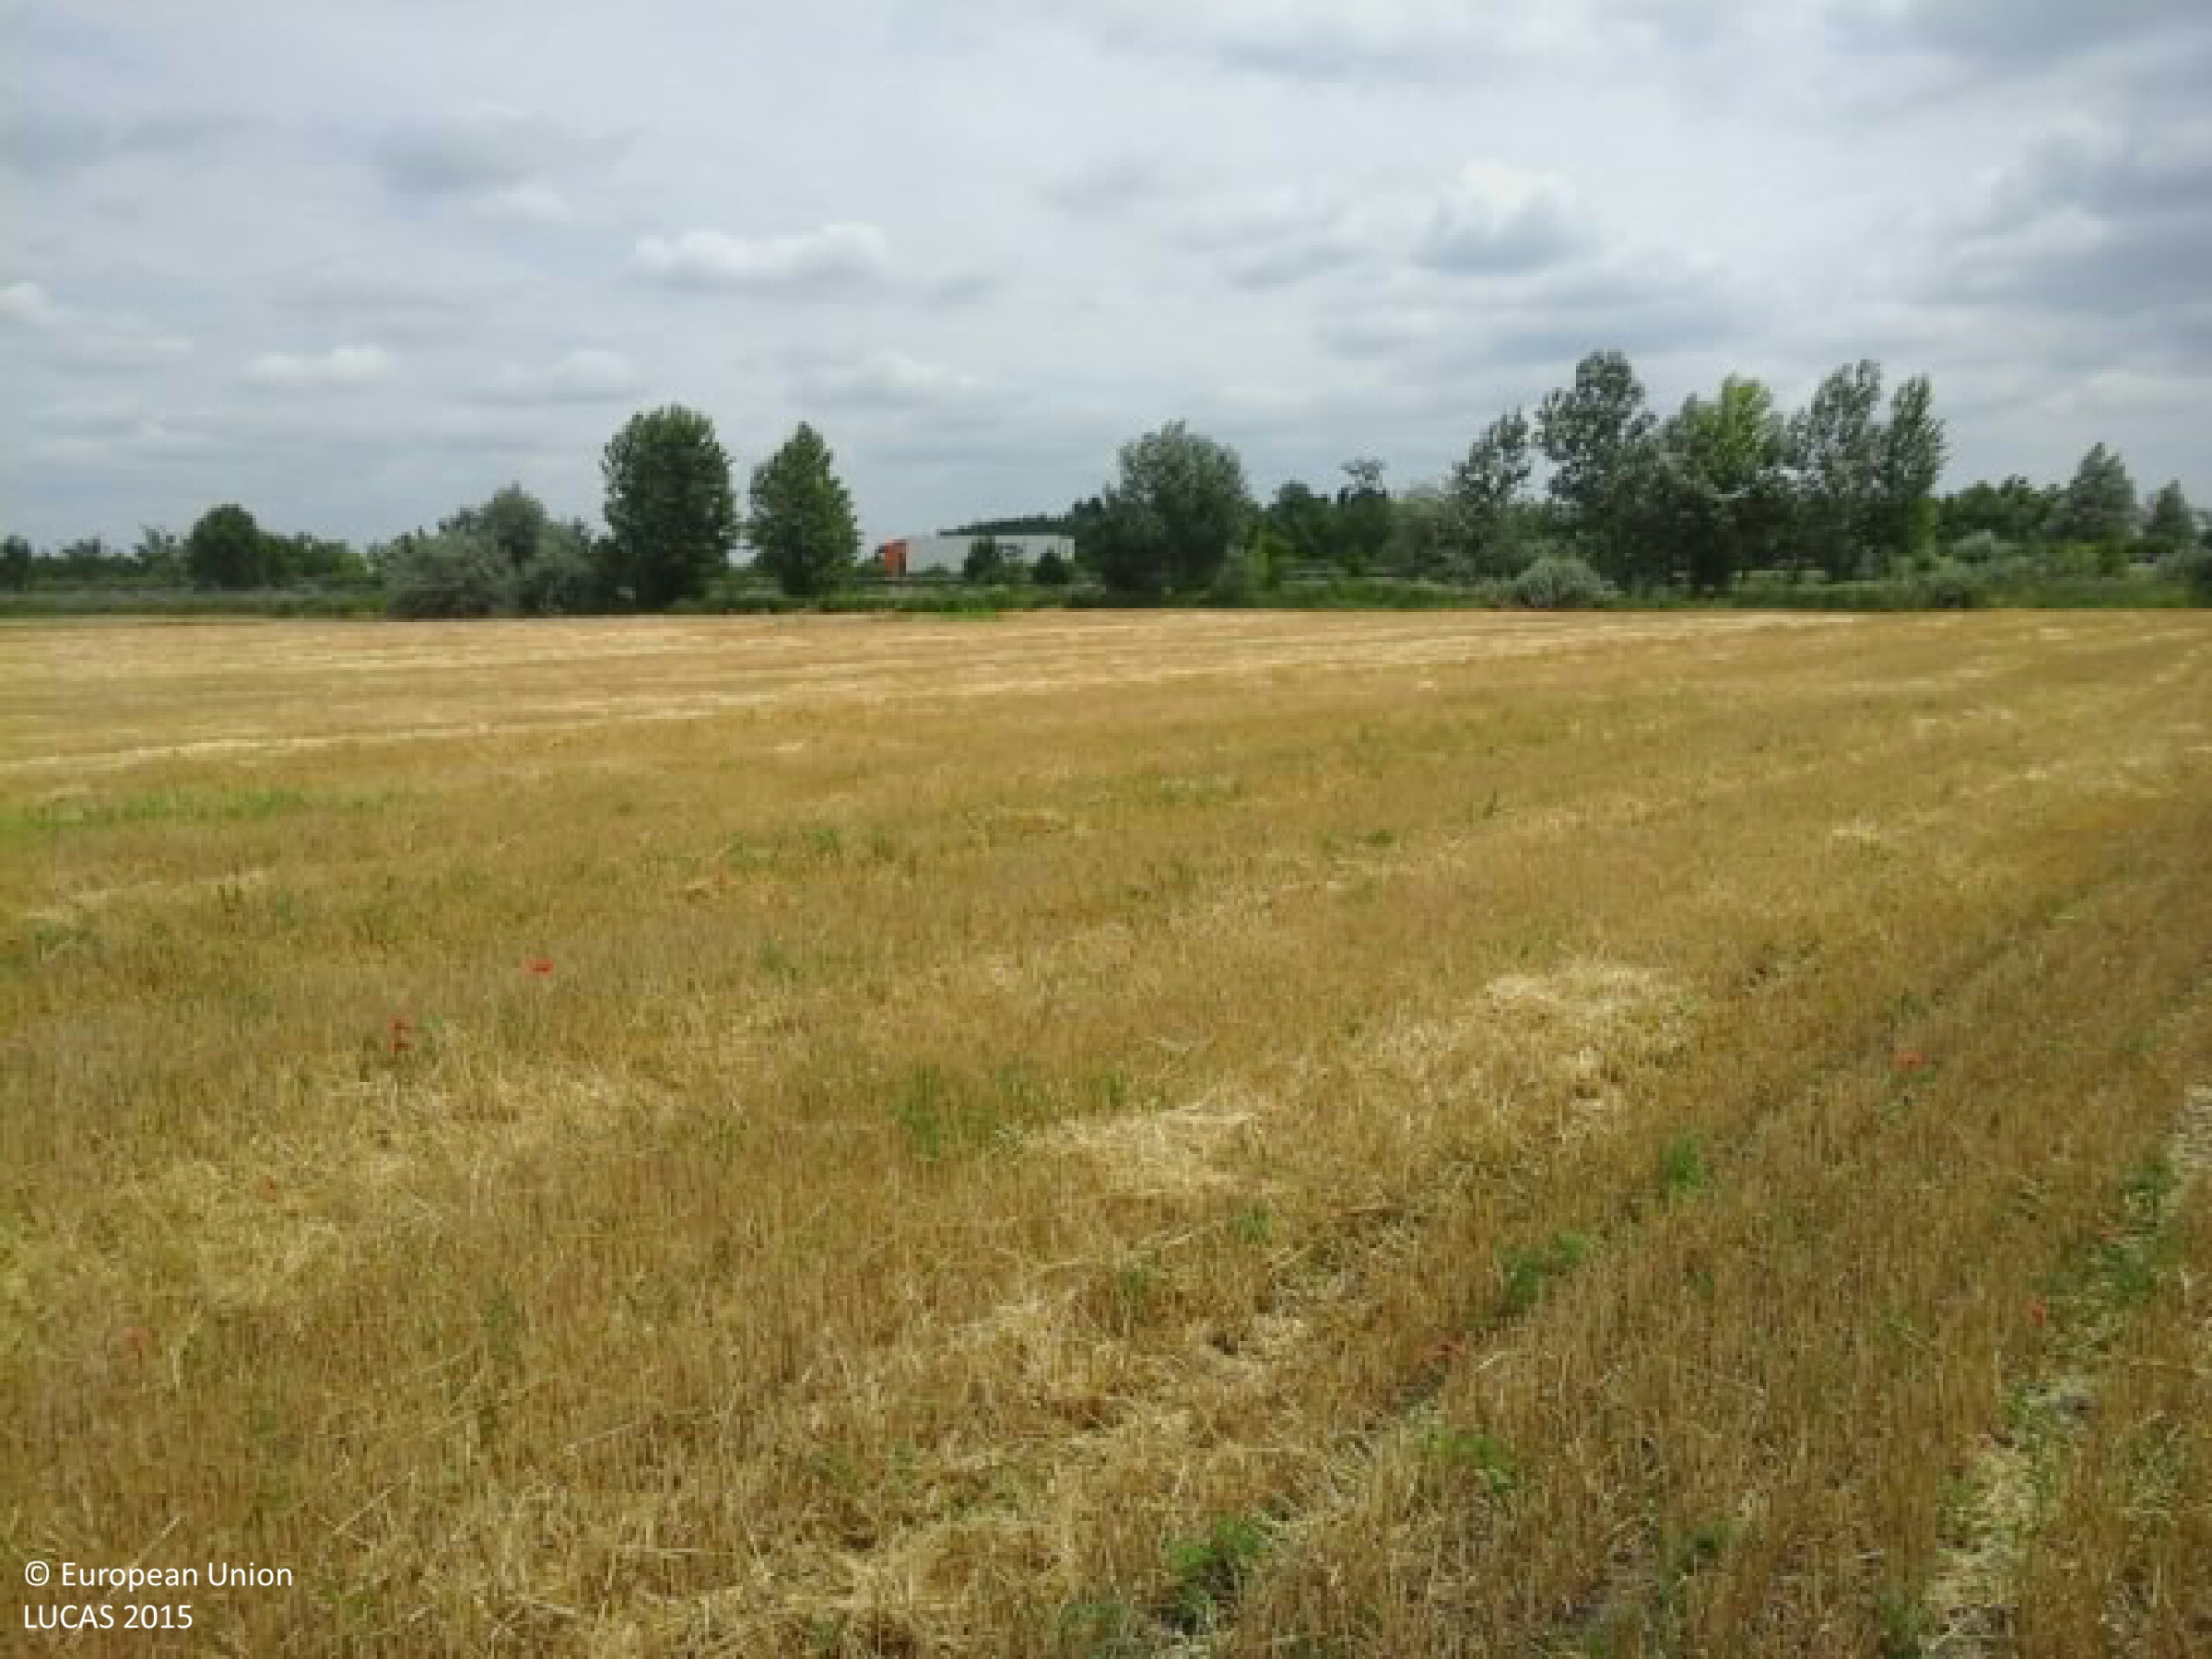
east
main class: Cropland
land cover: Barley
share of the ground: 50 - 75 %
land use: Agriculture (excluding fallow land and kitchen gardens)
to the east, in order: Barley; Shruby margins; Ditches and canals; Grass margins; Paved roads, cycling and walking lanes; Shruby margins; Fences; Grassland with sparse tree/shrub cover; Ditches and canals; Grassland without tree/shrub cover; Paved roads, cycling and walking lanes; Grass margins; Ditches and canals; Shruby margins; Fences; Grassland without tree/shrub cover; Shrubland with sparse tree cover; Paved roads, cycling and walking lanes
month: June
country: HU
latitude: 46.2068
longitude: 20.0133
